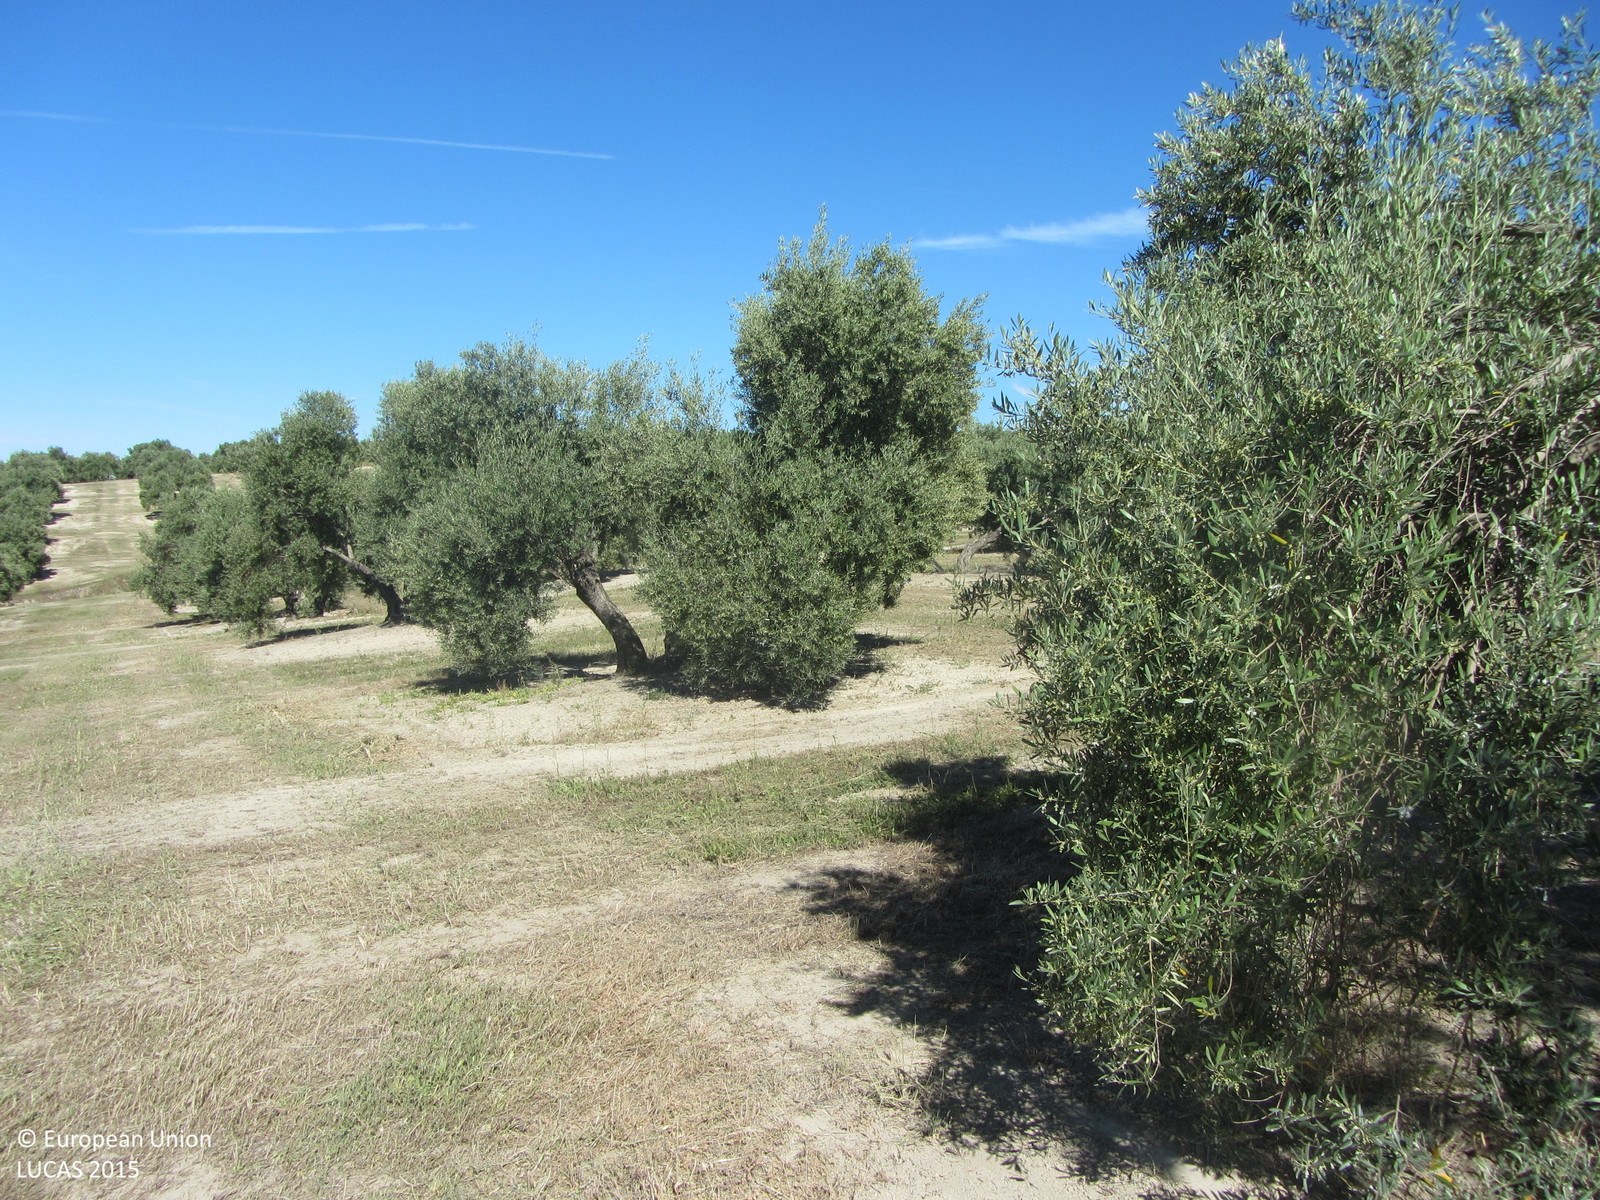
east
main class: Cropland
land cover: Olive groves
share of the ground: 25 - 50 %
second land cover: Spontaneously vegetated surfaces
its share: 50 - 75 %
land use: Agriculture (excluding fallow land and kitchen gardens)
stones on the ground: < 10 %
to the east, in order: Olive groves; Spontaneously vegetated surfaces; Other structural elements; Olive groves
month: May
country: ES
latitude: 38.0763
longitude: -3.4190
